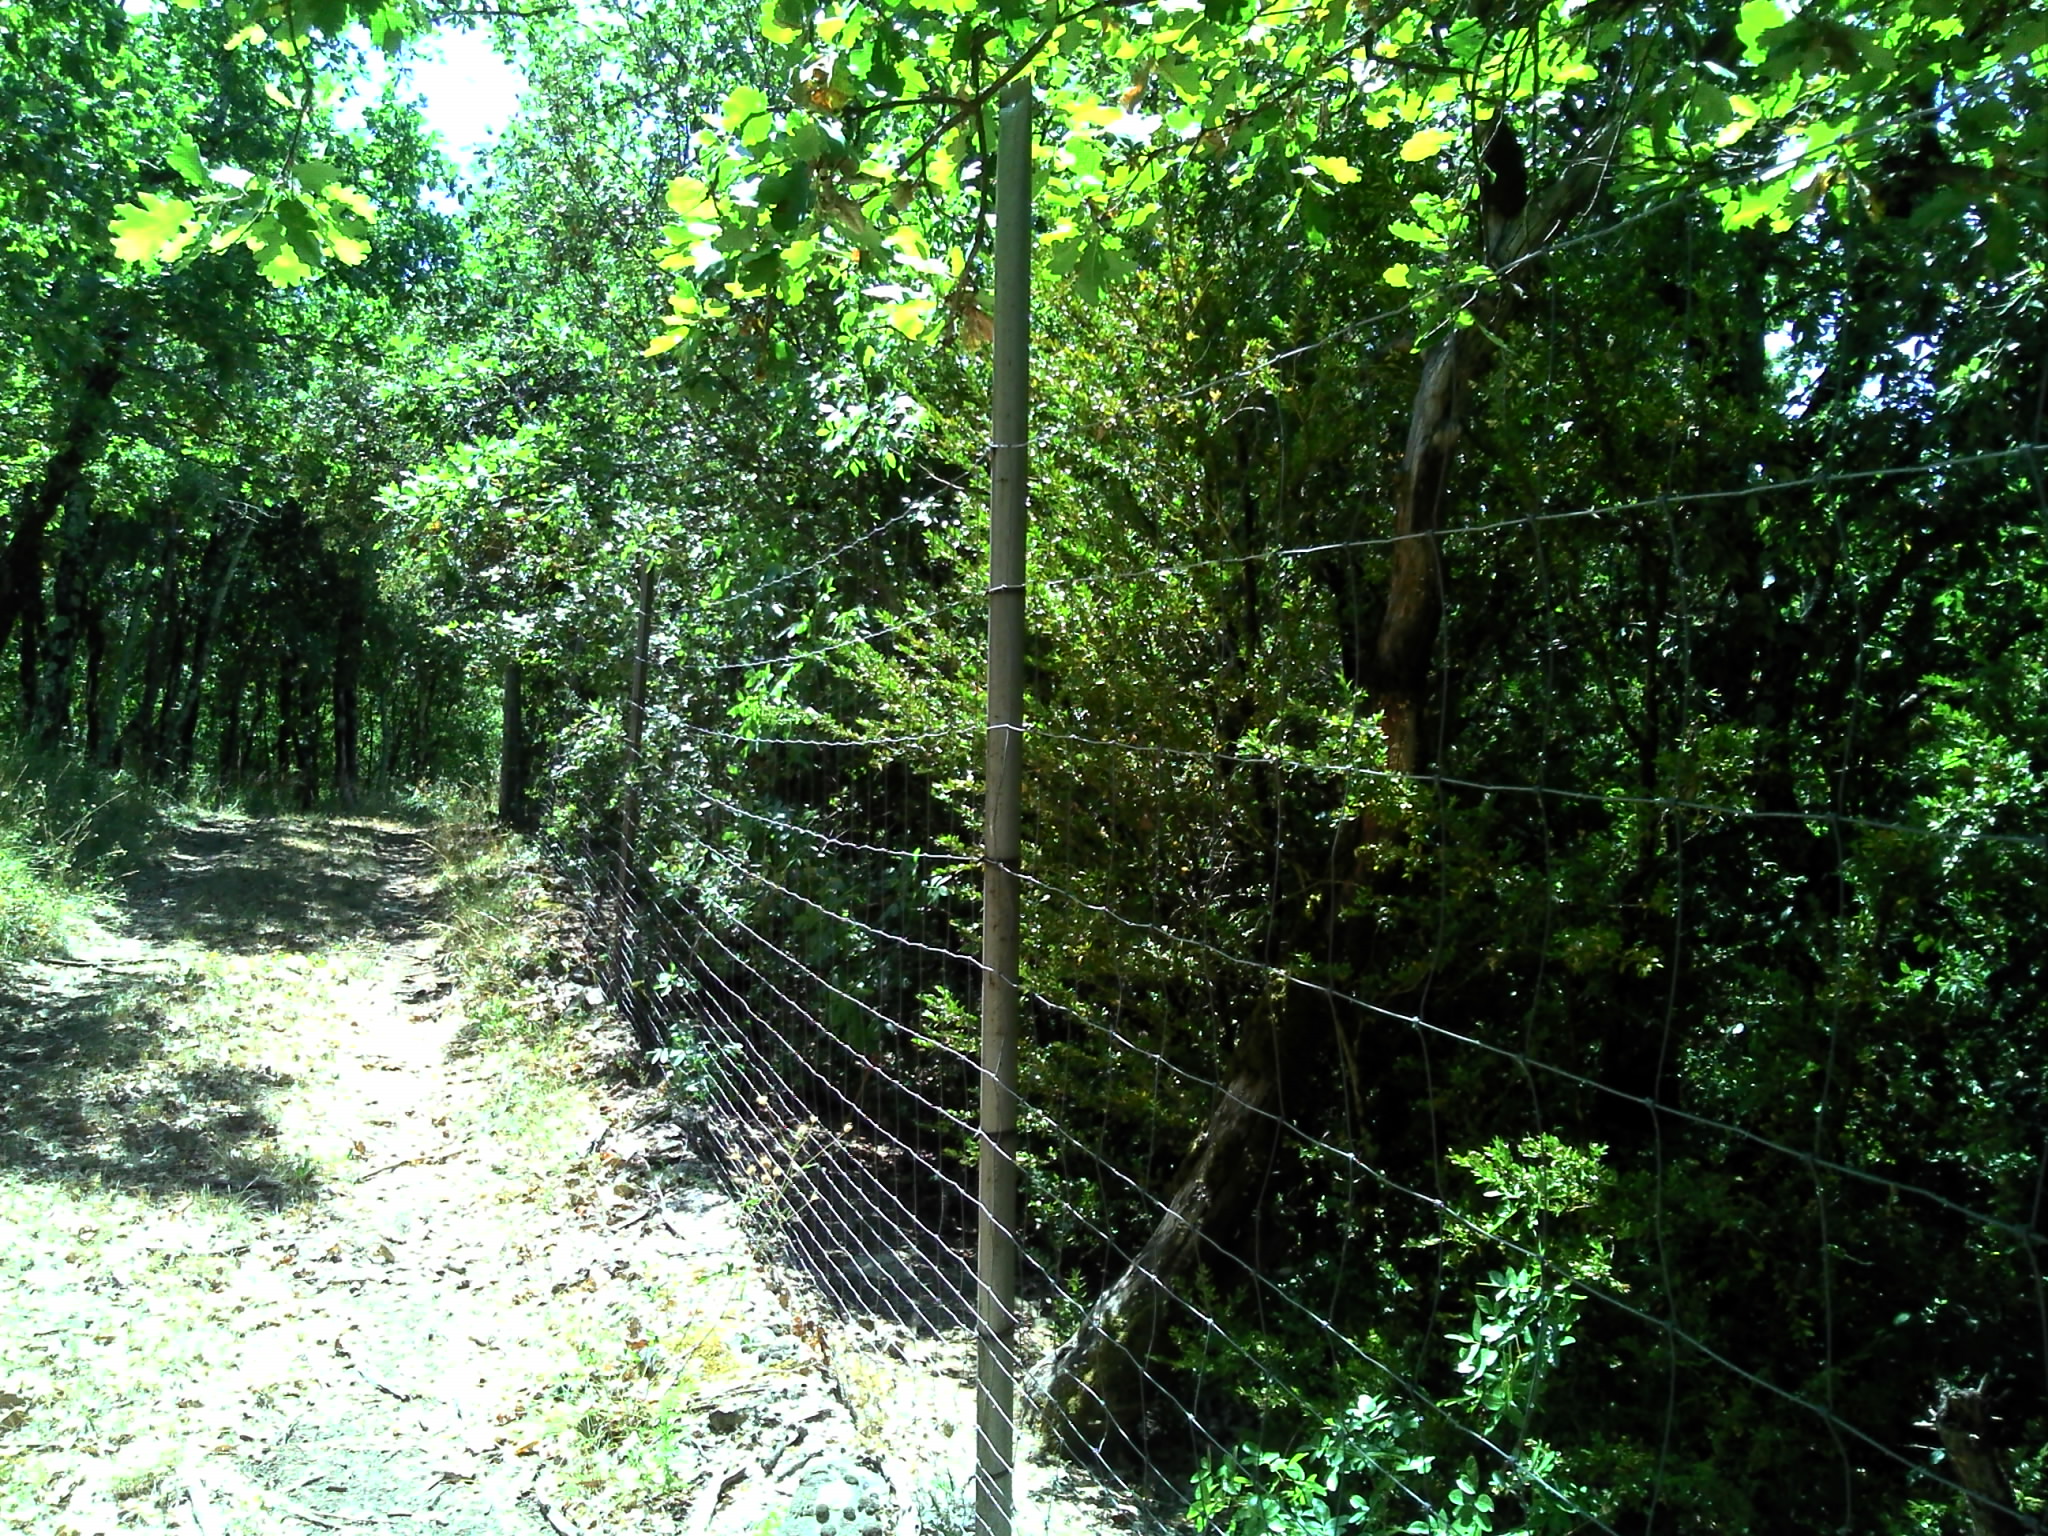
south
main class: Woodland
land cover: Broadleaved woodland
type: acidophilous oak and oak-birch forest
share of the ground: > 75 %
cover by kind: broadleaved forest trees 70 %, herbaceous plants 15 %, consolidated bare surface 15 %
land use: Semi-natural and natural areas not in use
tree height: > 5 m
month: July
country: FR
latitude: 44.1753
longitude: 4.2915
